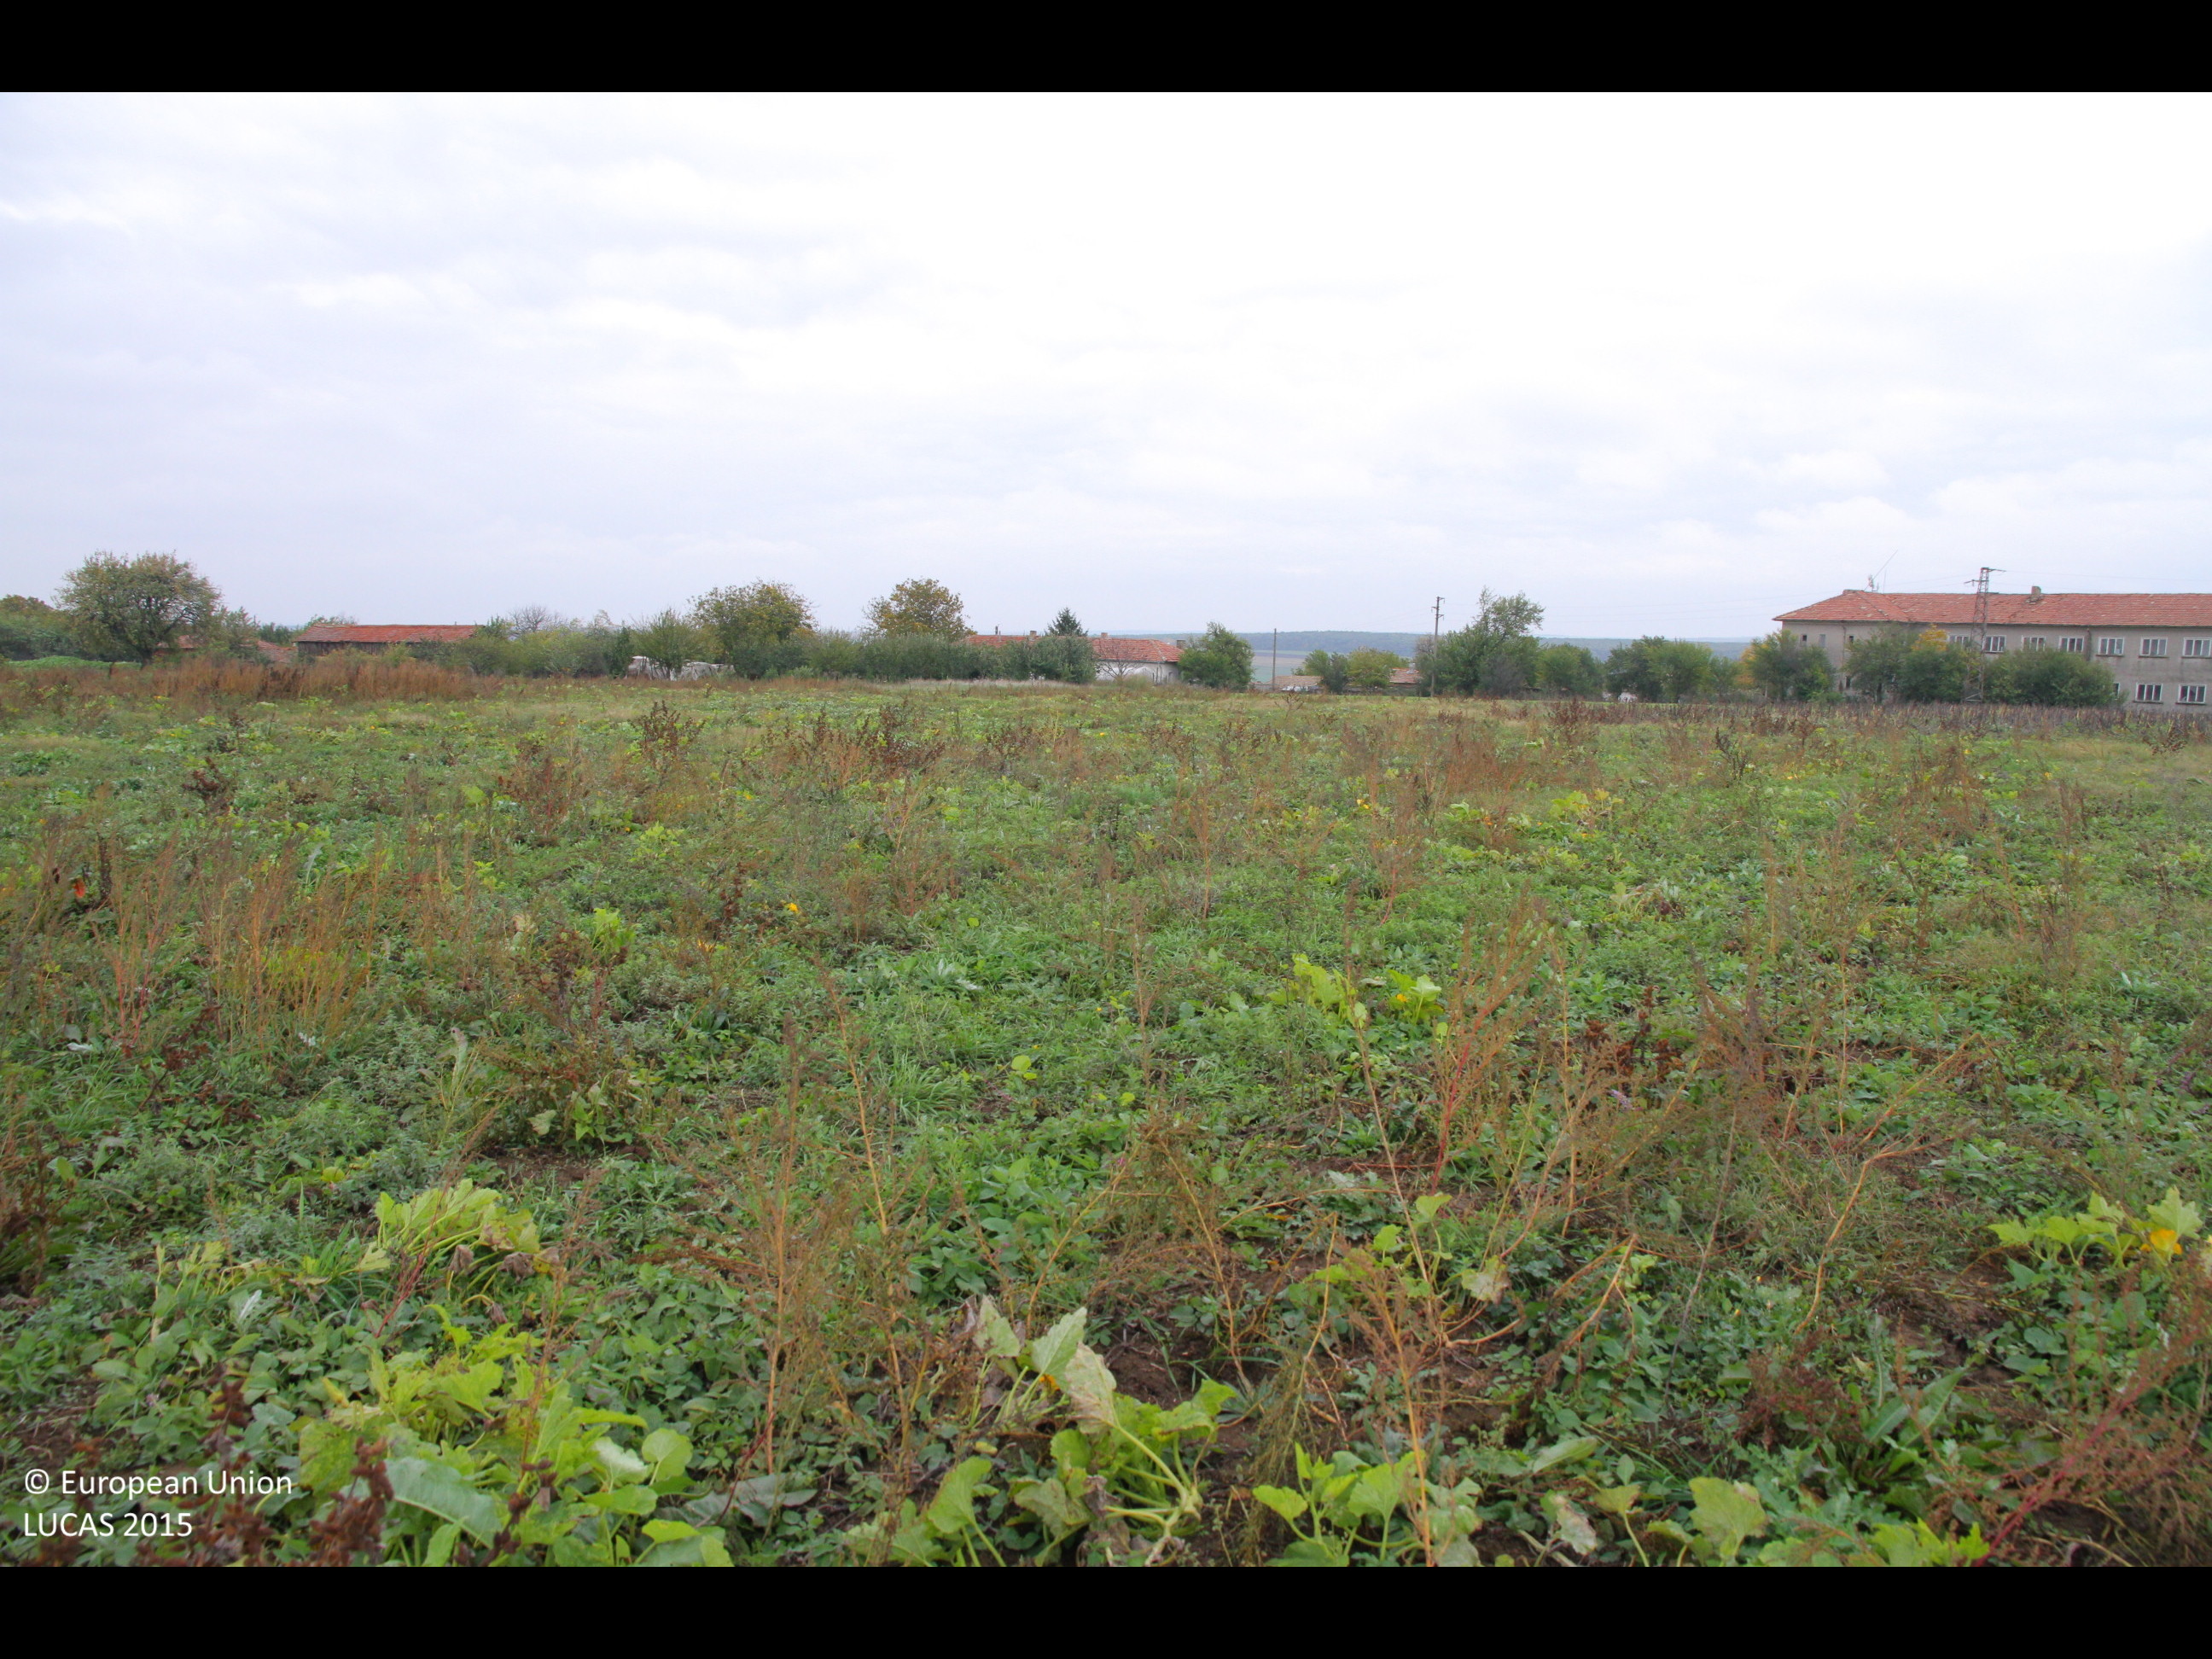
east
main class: Cropland
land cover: Other fresh vegetables
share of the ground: 10 - 25 %
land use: Agriculture (excluding fallow land and kitchen gardens)
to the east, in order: Other fresh vegetables; Grassland without tree/shrub cover; Artificial constructions in urban areas
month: October
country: BG
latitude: 43.5434
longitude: 26.8849
